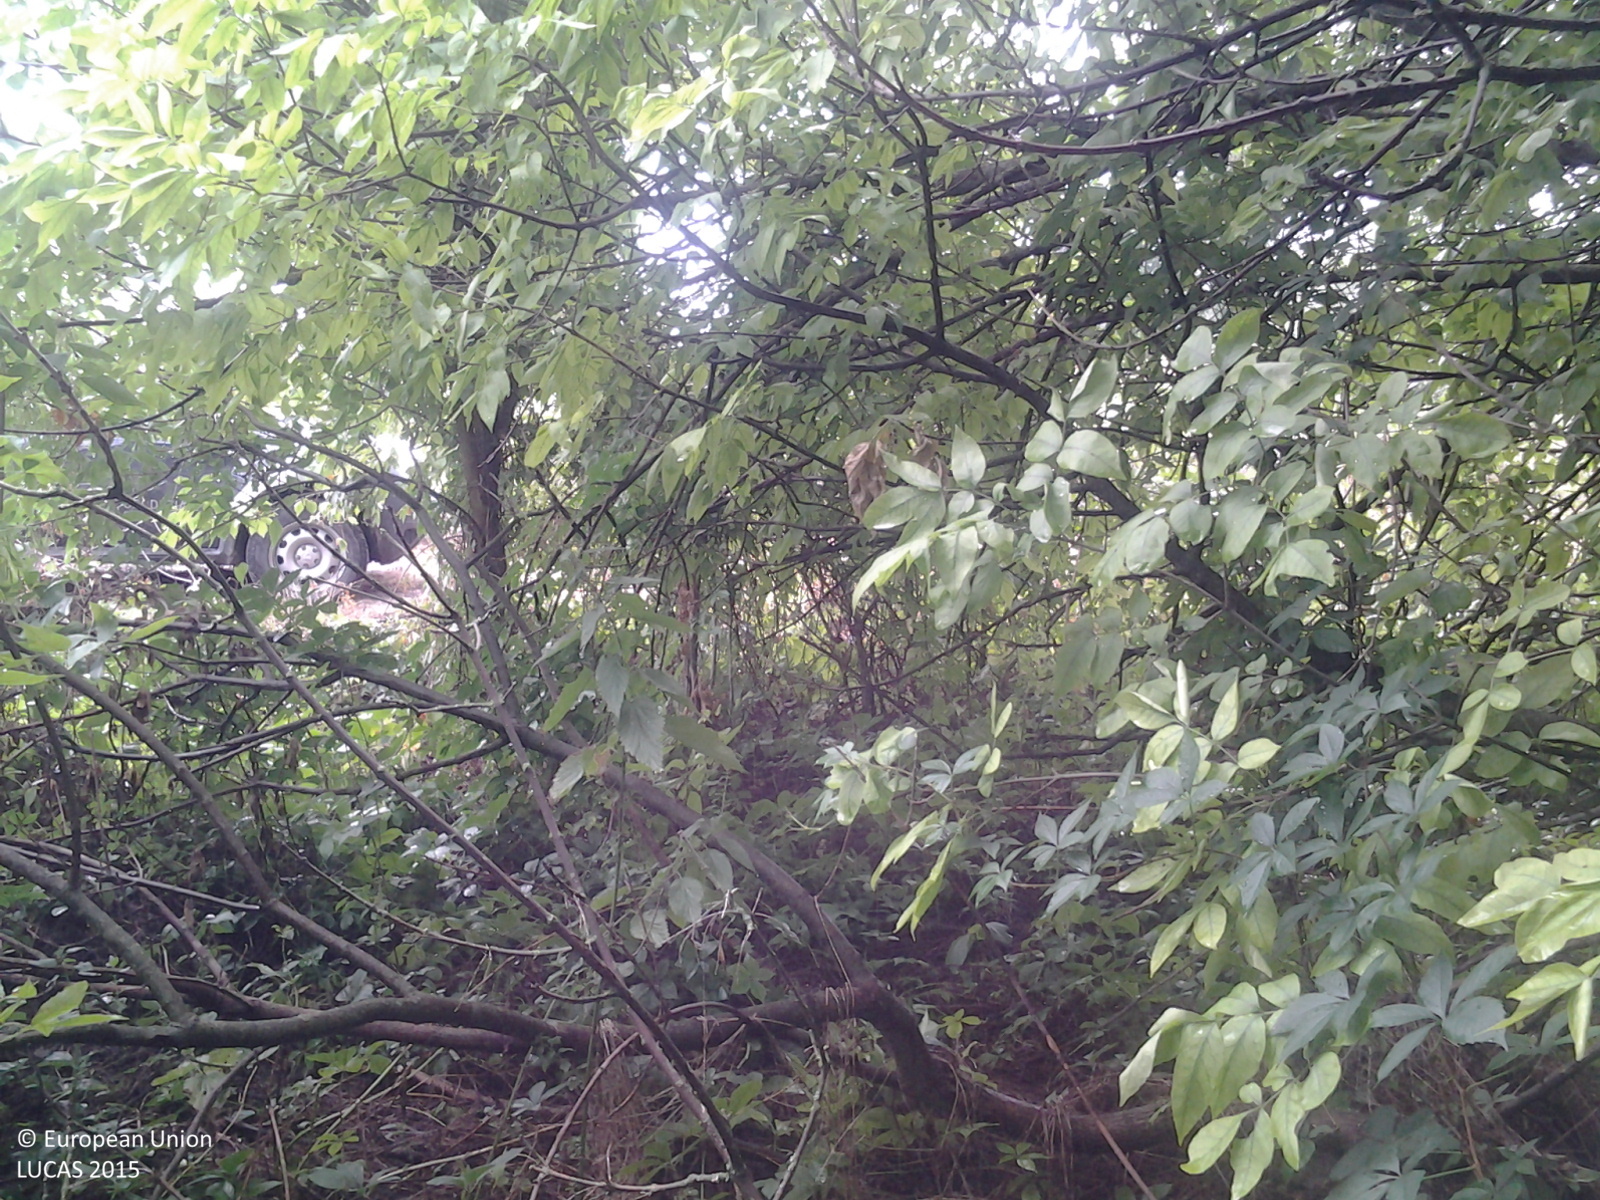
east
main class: Woodland
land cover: Broadleaved woodland
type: mesophytic deciduous forest
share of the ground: 50 - 75 %
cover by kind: broadleaved forest trees 60 %, shrubs 20 %, herbaceous plants 20 %
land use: Forestry
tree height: > 5 m
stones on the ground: < 10 %
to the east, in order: Broadleaved woodland; Grass margins; Tracks; Grass margins; Maize
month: August
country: HU
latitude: 46.9407
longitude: 21.2158
